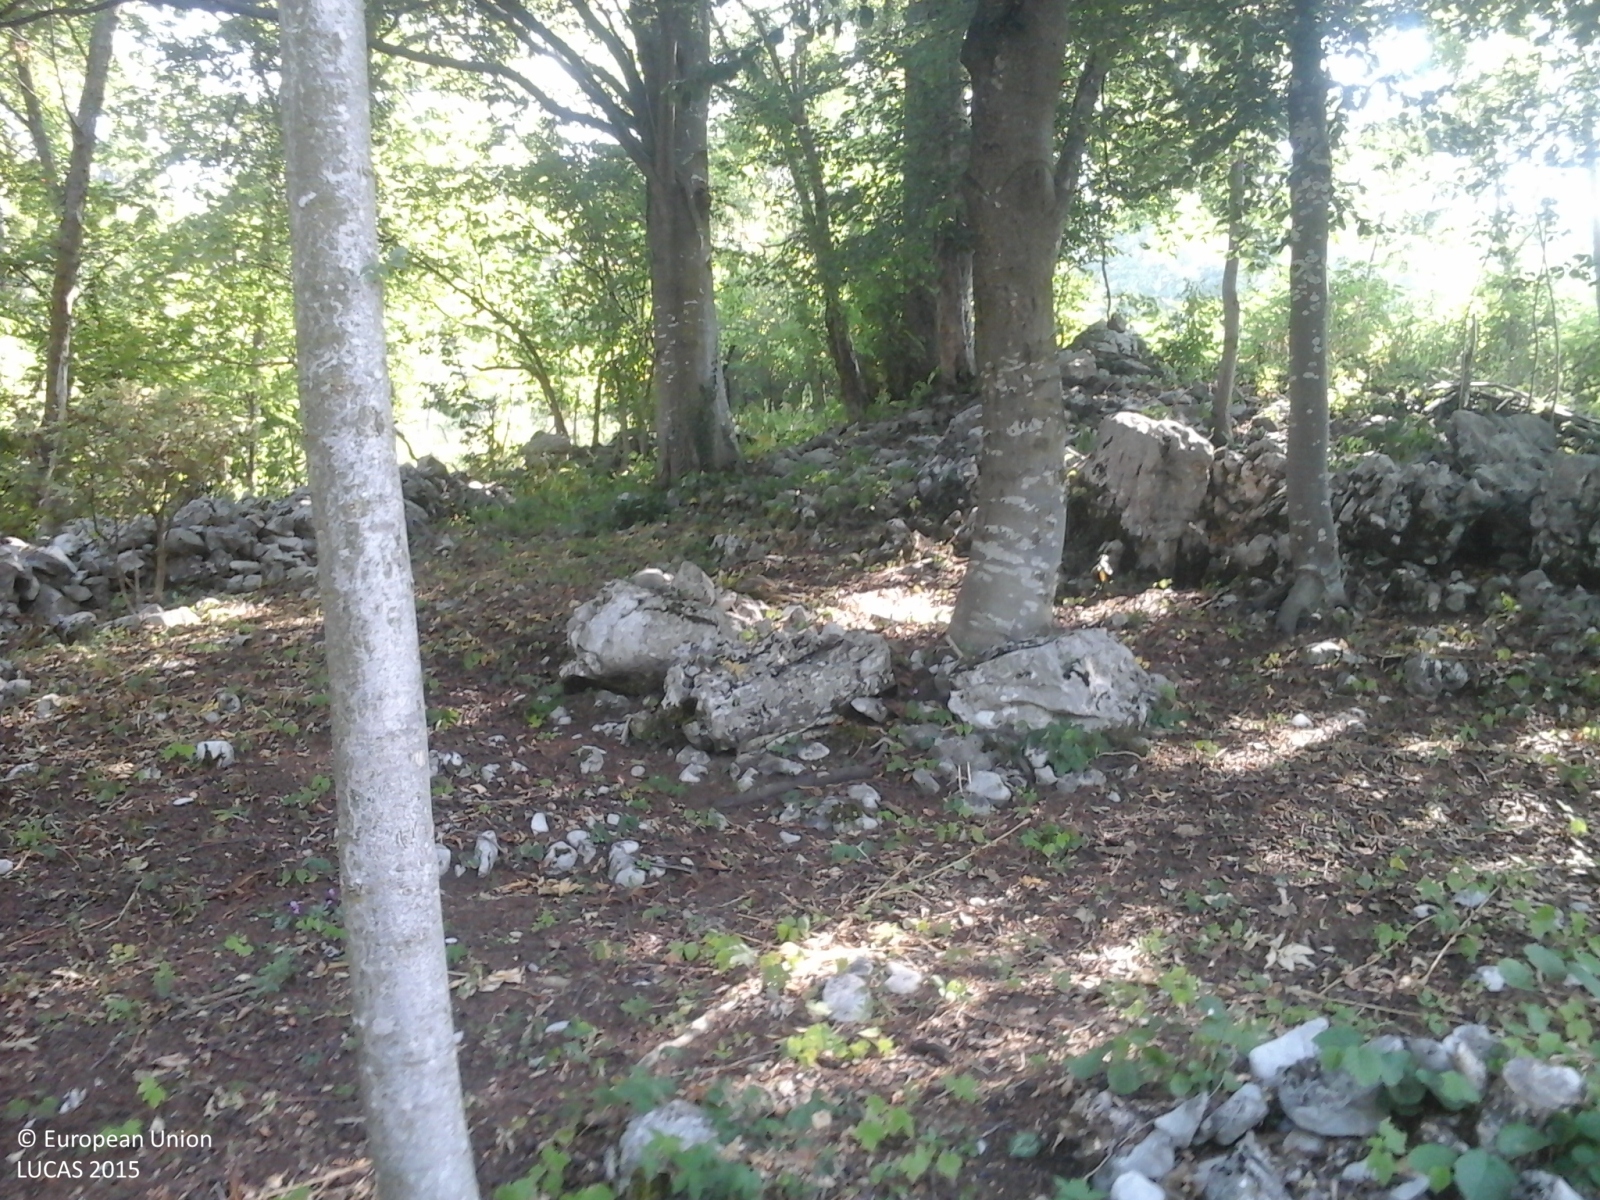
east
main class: Woodland
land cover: Broadleaved woodland
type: thermophilous deciduous forest
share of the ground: > 75 %
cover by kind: broadleaved forest trees 100 %
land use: Forestry
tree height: > 5 m
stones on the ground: 25 - 50 %
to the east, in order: Broadleaved woodland; Grassland without tree/shrub cover; Managed hedges; Artificial constructions in urban areas; Broadleaved woodland; Paved roads, cycling and walking lanes; Managed hedges; Grassland with sparse tree/shrub cover; Paved roads, cycling and walking lanes; Grassland without tree/shrub cover; Electric lines; Grassland without tree/shrub cover; Broadleaved woodland; Grassland without tree/shrub cover; Broadleaved woodland
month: July
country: IT
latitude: 45.7915
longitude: 9.4991
